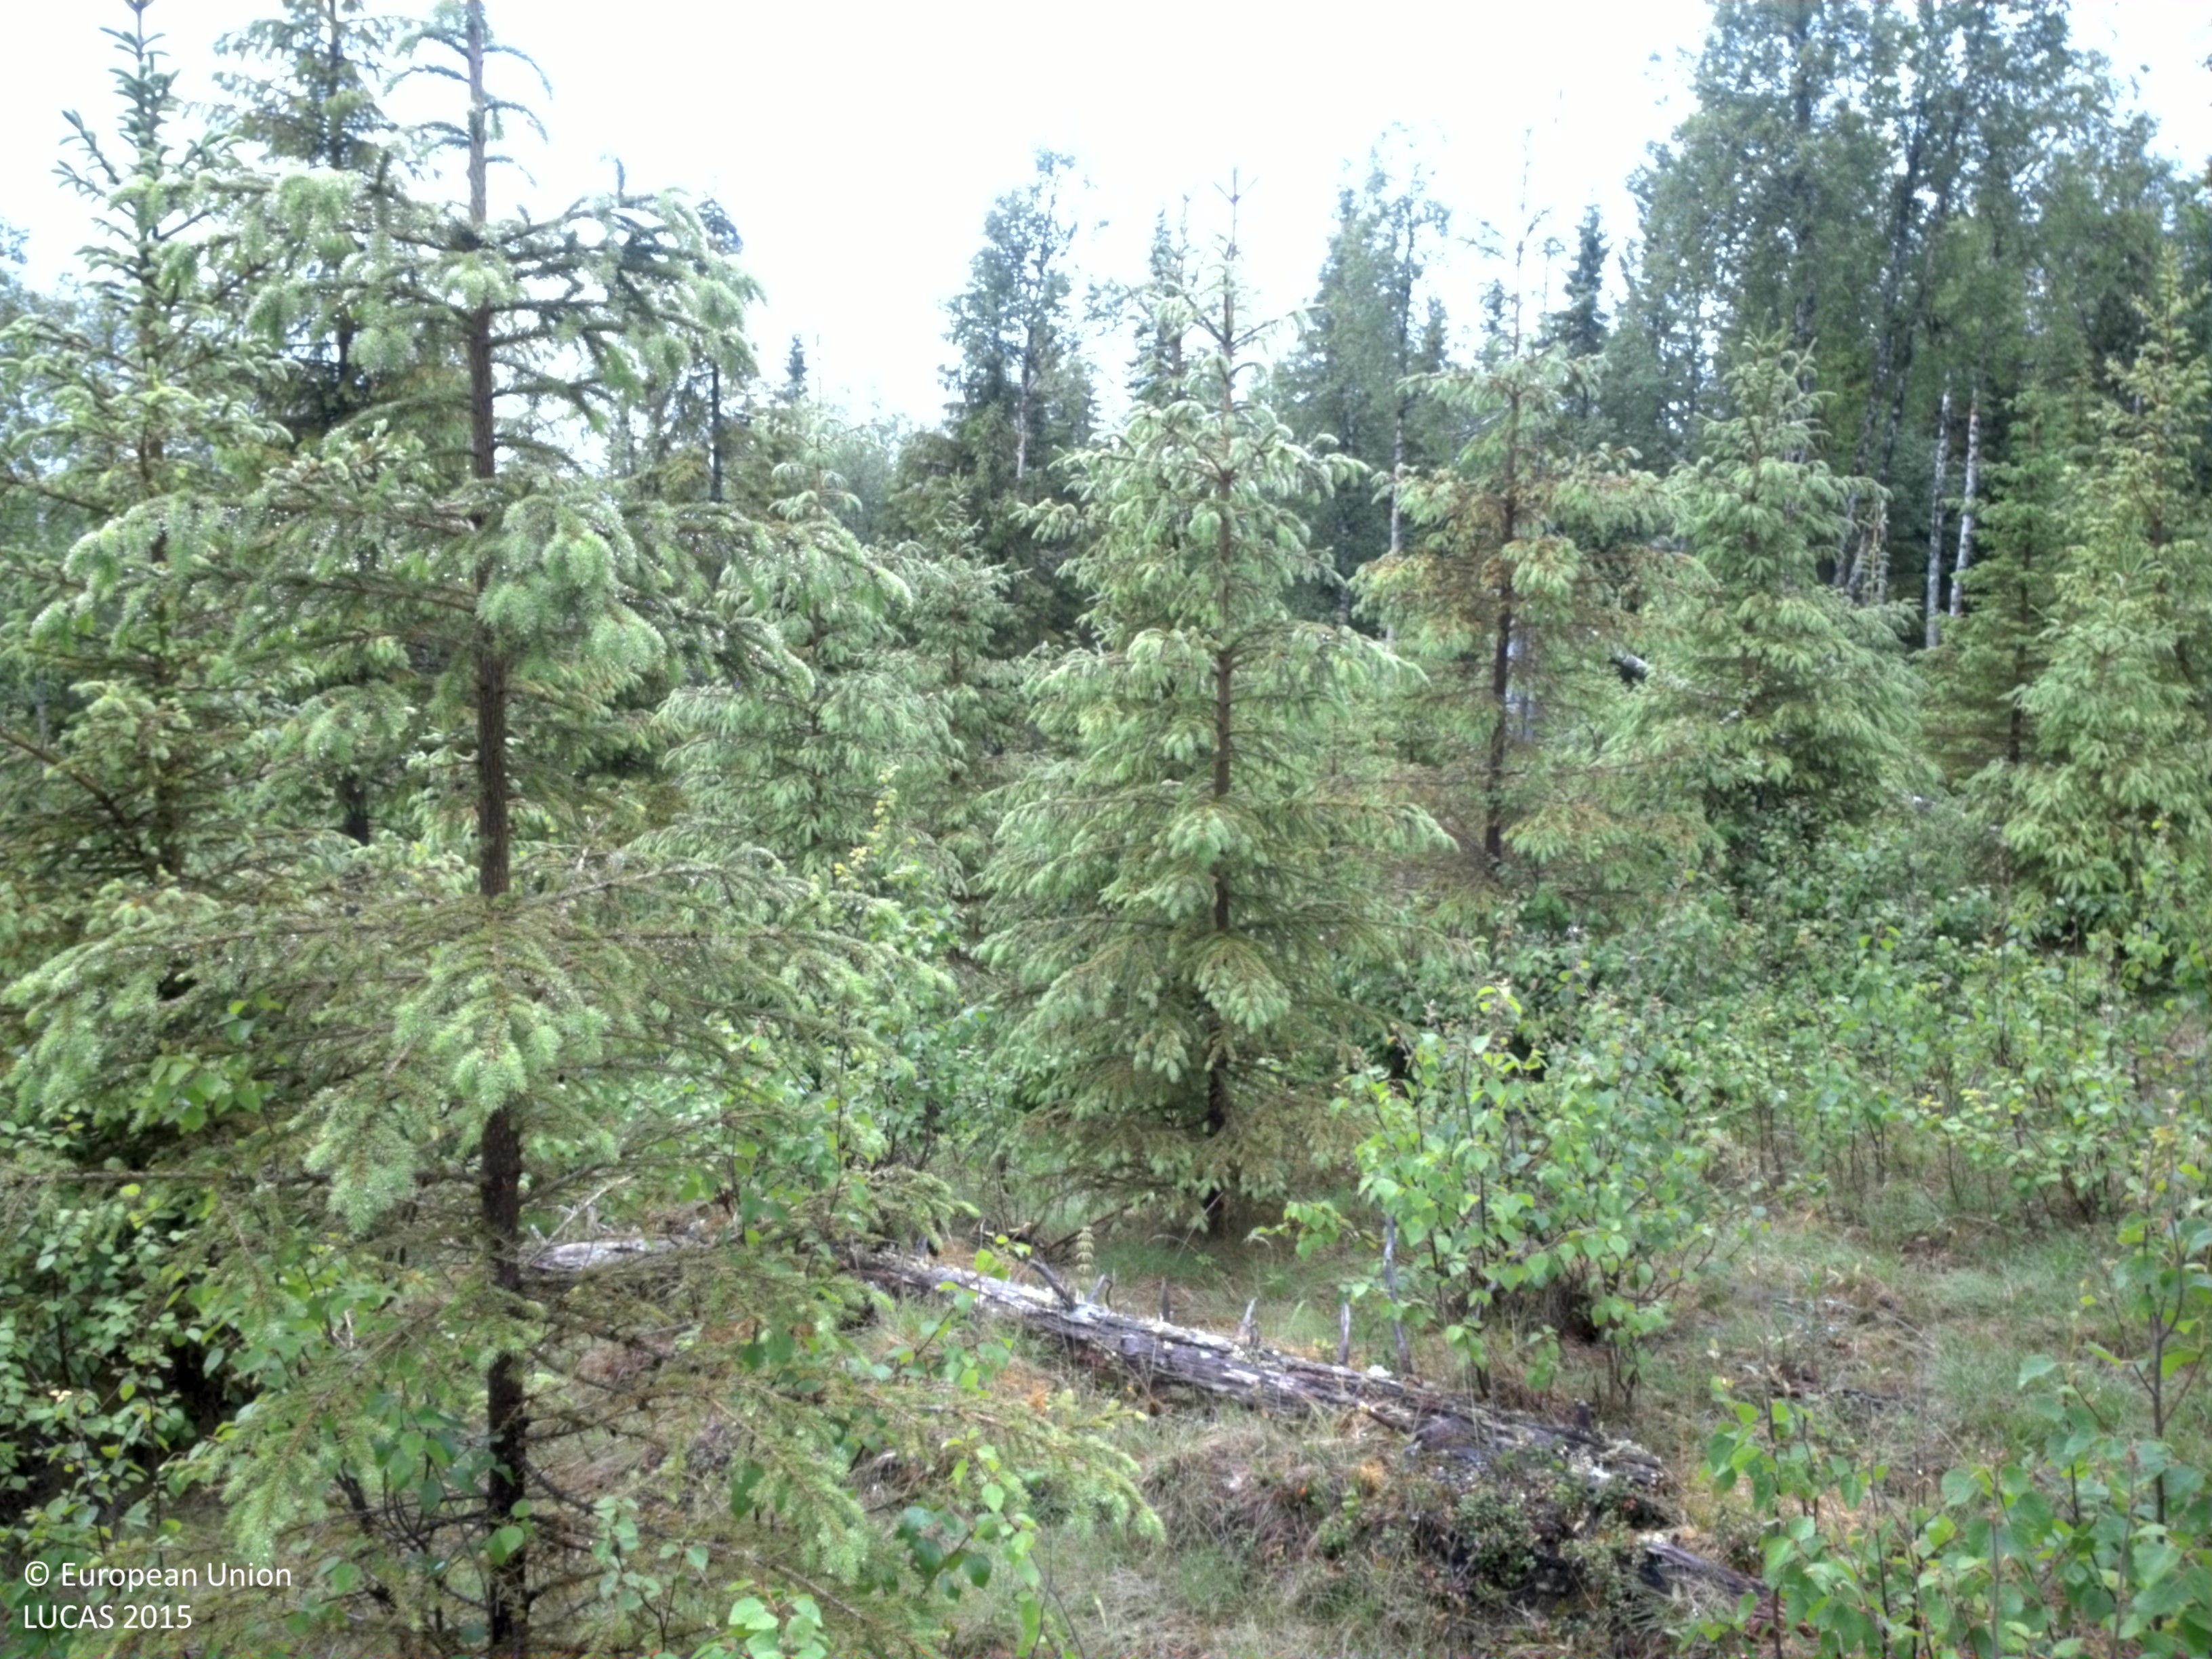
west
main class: Woodland
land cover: Spruce dominated mixed woodland
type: boreal forest
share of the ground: 50 - 75 %
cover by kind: coniferous forest trees 45 %, herbaceous plants 20 %, broadleaved forest trees 15 %, shrubs 15 %, lichens and mosses 5 %
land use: Forestry
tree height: > 5 m
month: July
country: SE
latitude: 64.3573
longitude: 18.3985
